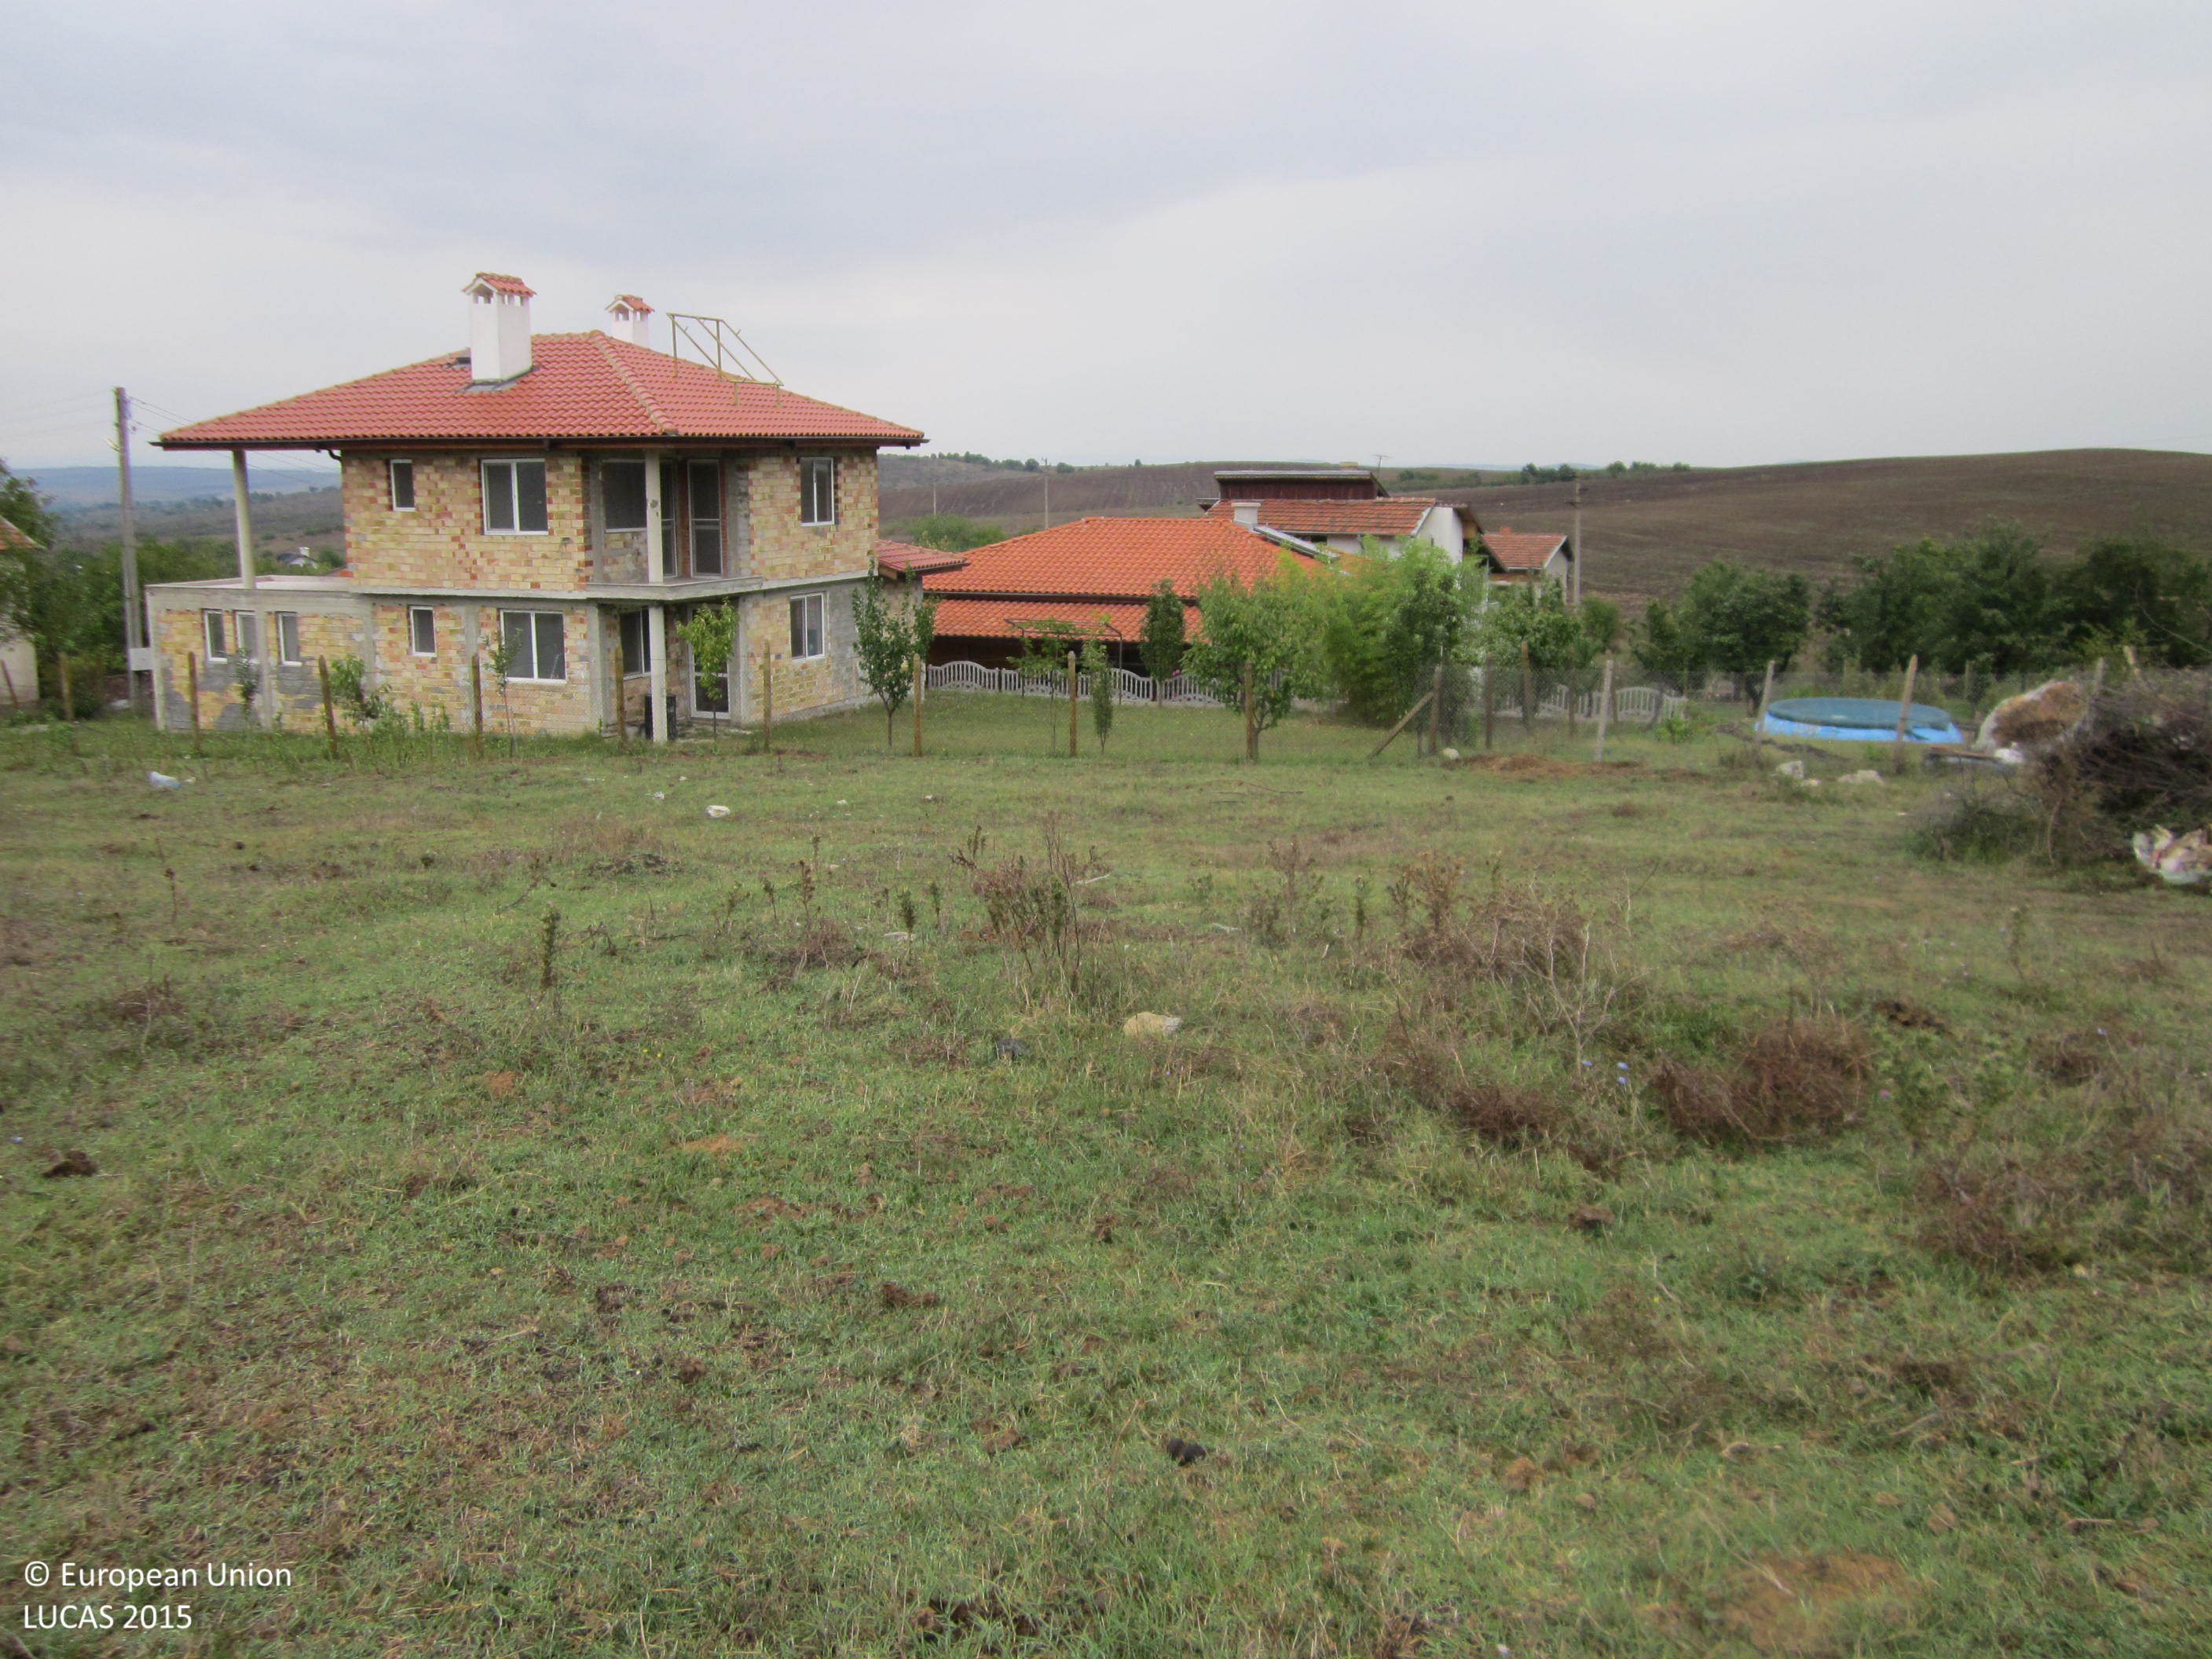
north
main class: Grassland
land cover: Grassland without tree/shrub cover
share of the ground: > 75 %
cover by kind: herbaceous plants 100 %
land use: Agriculture (excluding fallow land and kitchen gardens)
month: September
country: BG
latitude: 42.3384
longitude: 27.2592
